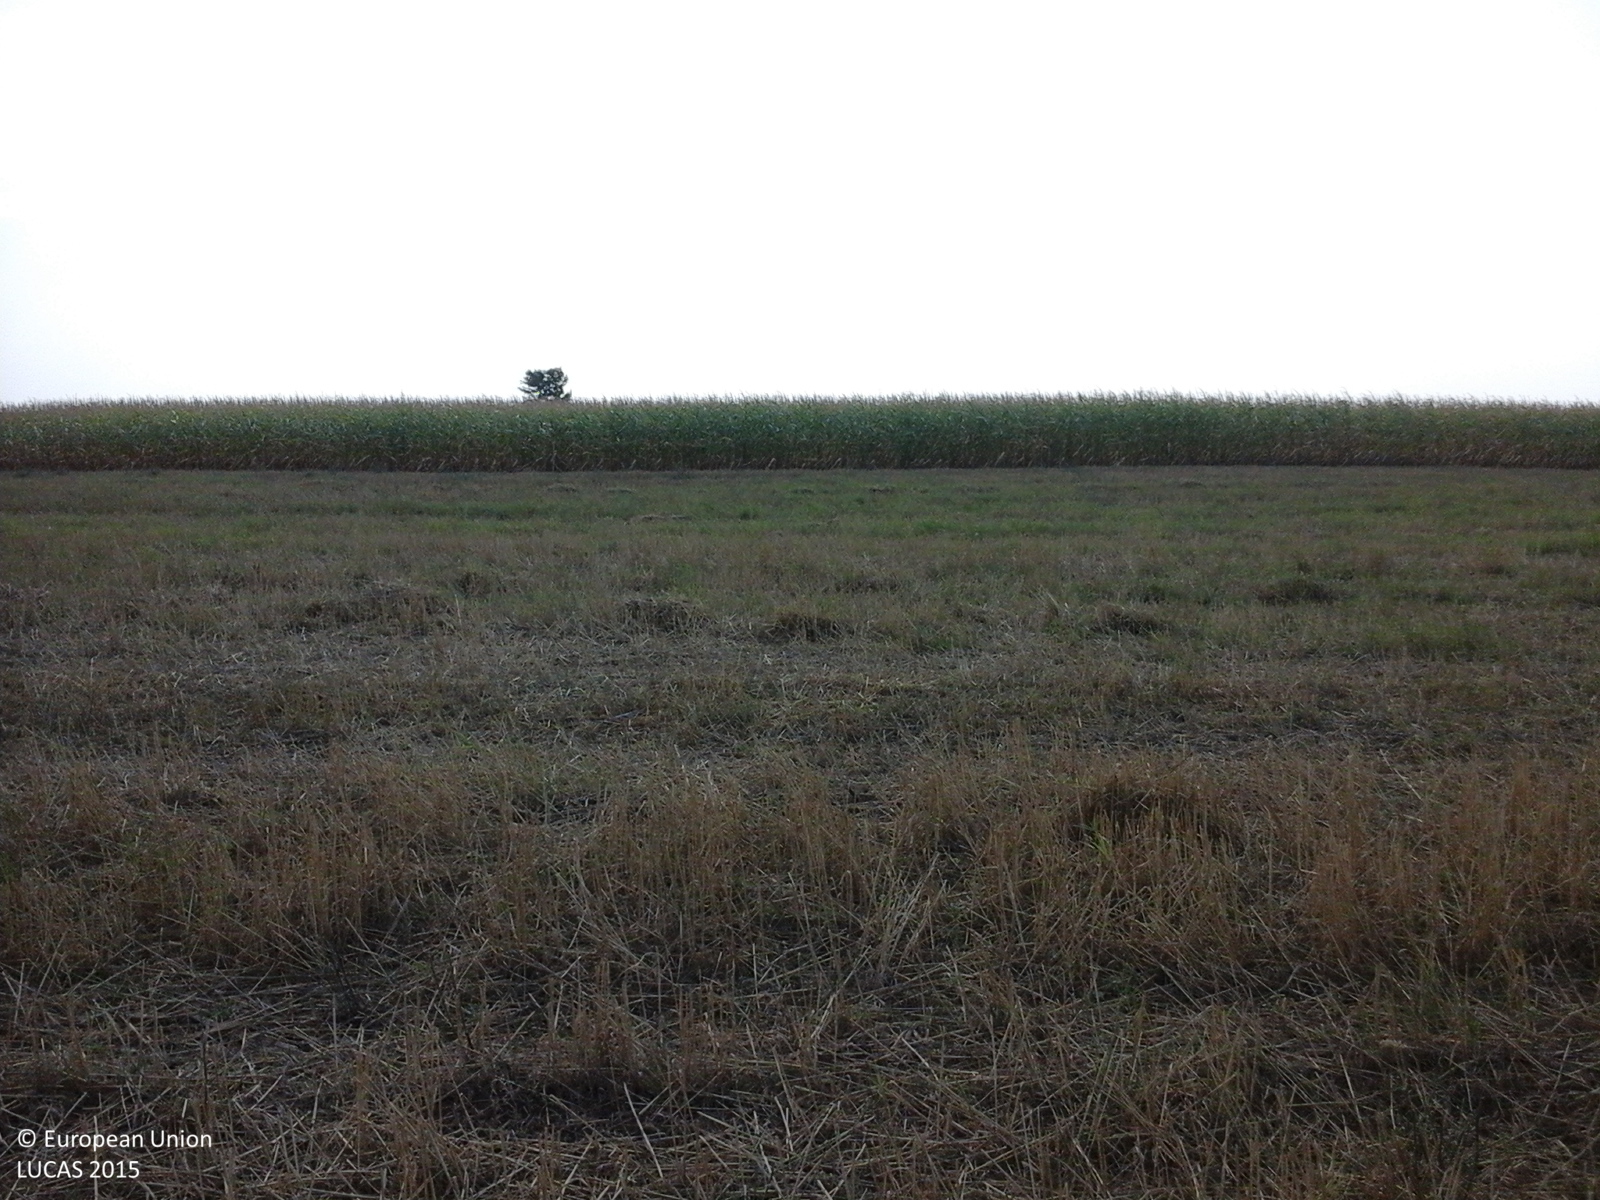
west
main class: Cropland
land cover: Barley
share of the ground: 50 - 75 %
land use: Agriculture (excluding fallow land and kitchen gardens)
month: August
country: RO
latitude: 45.2545
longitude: 27.5458
